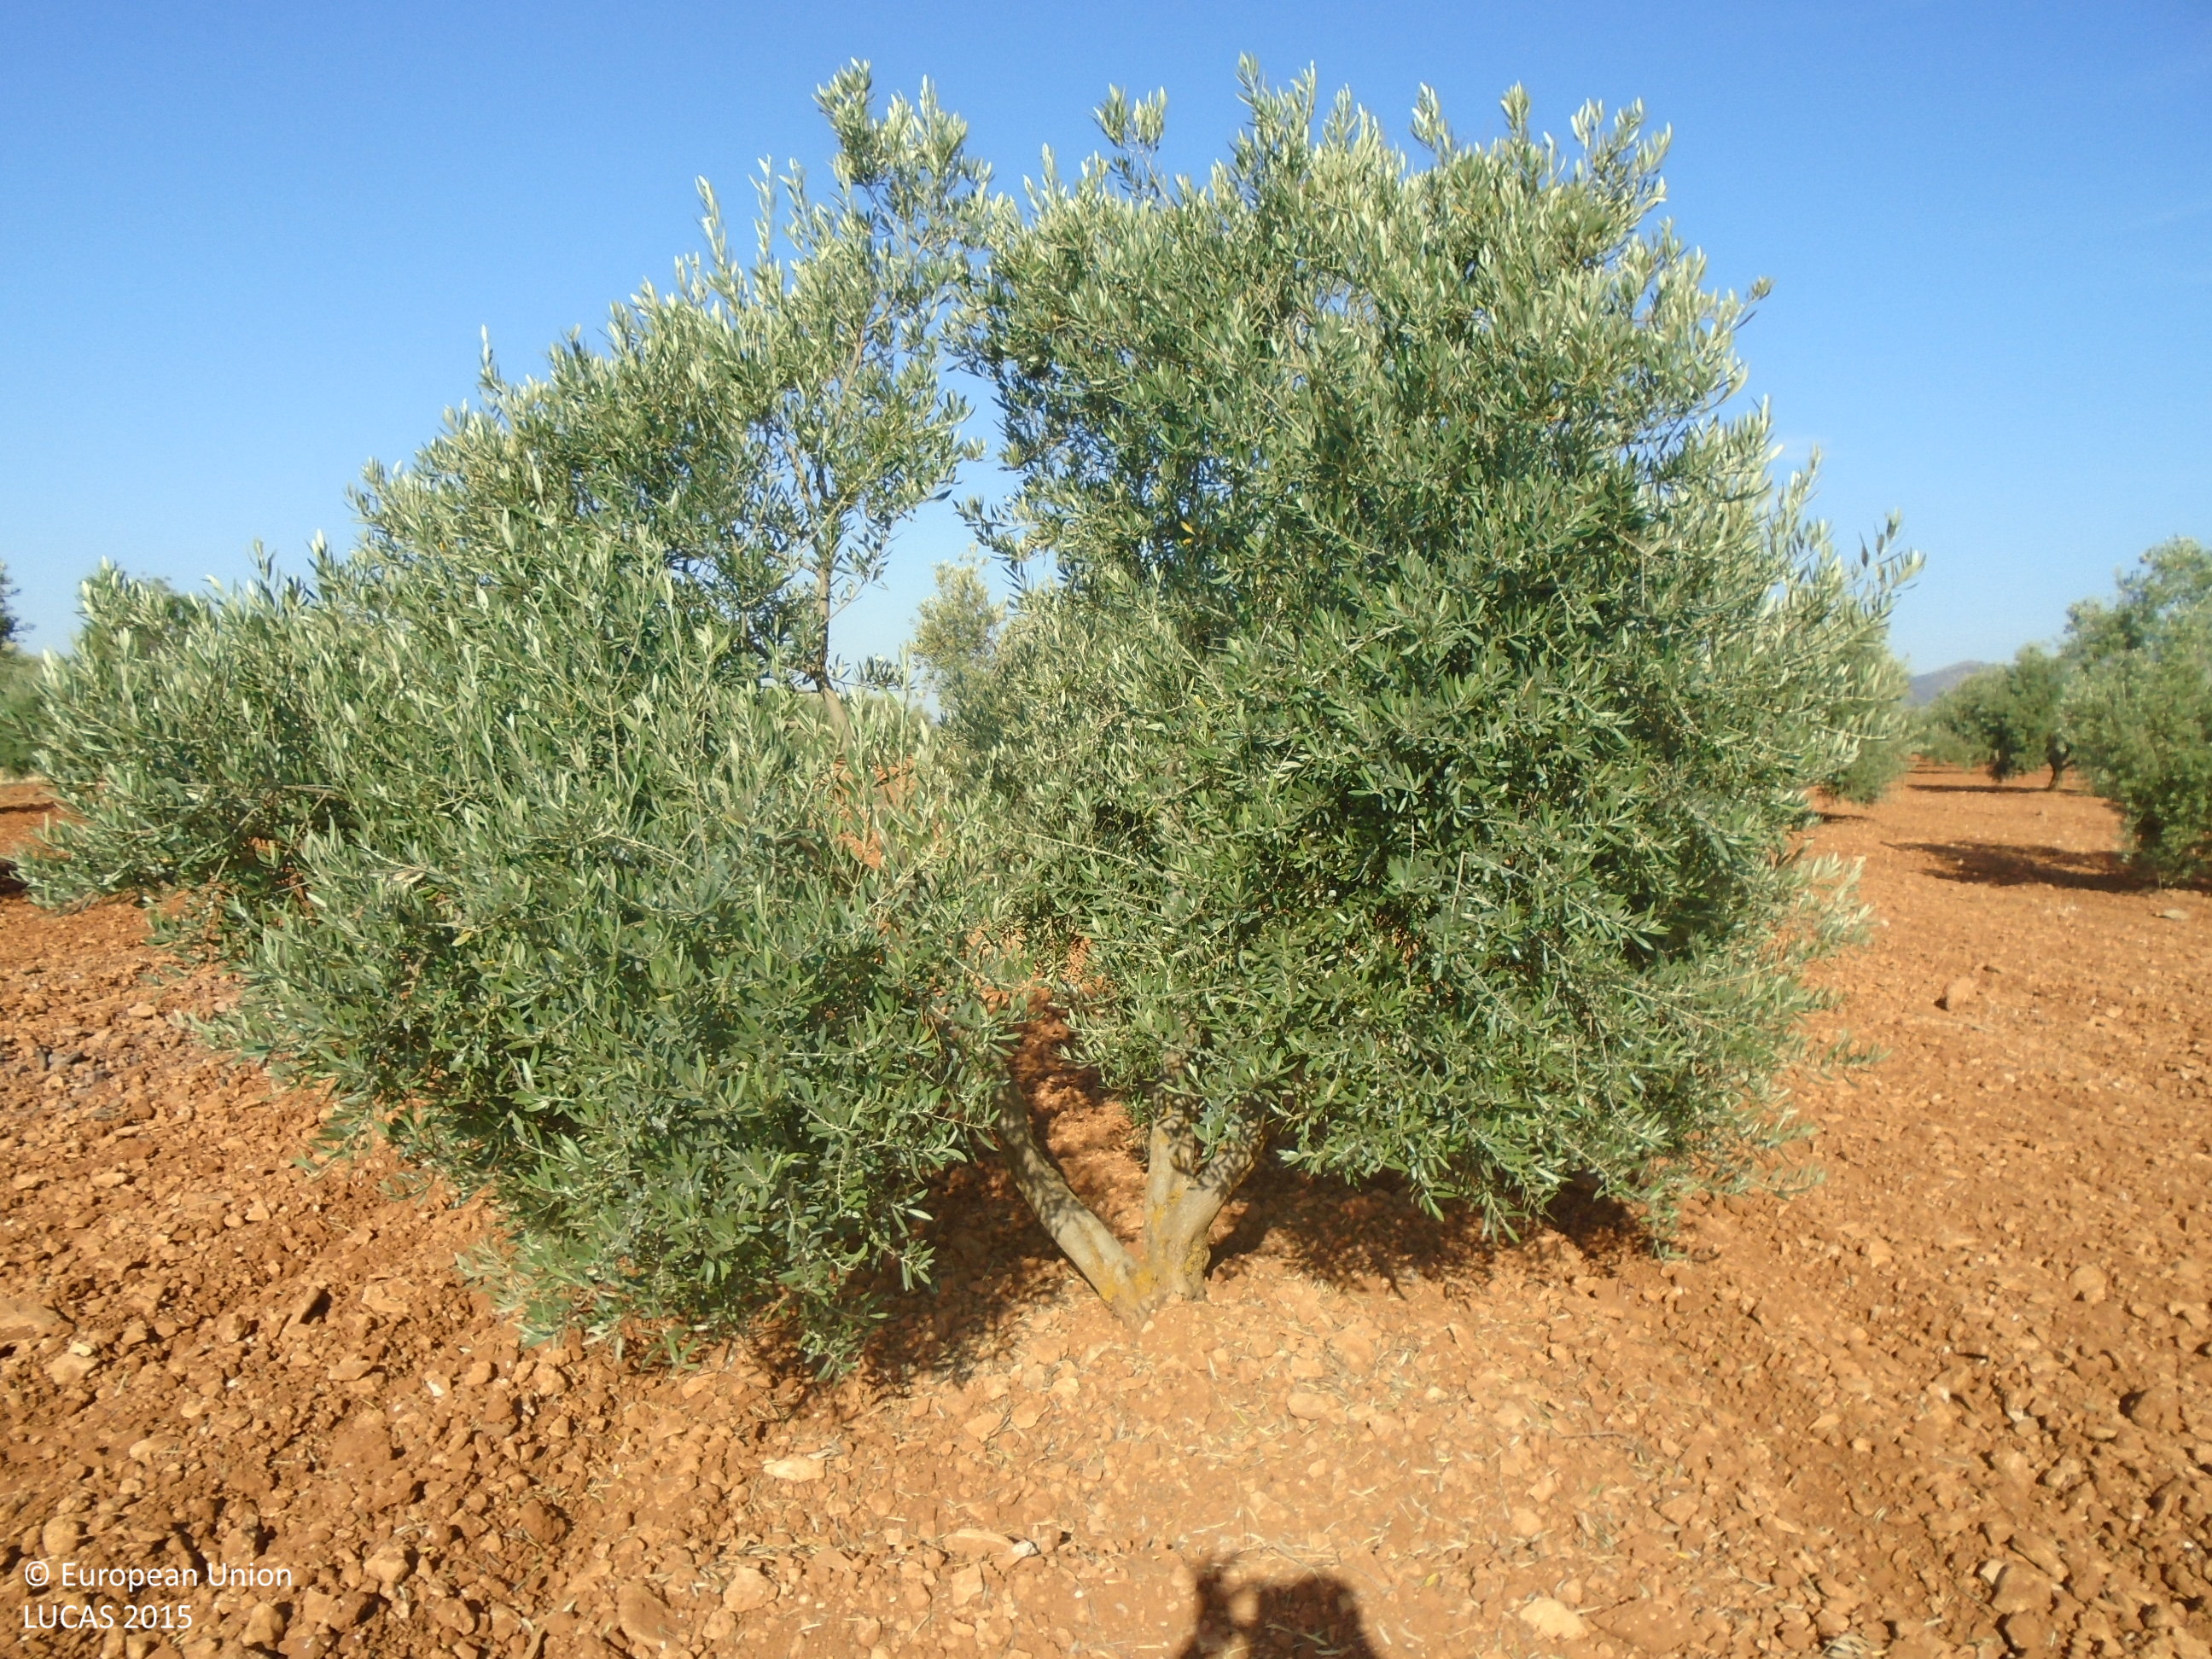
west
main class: Cropland
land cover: Olive groves
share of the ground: 10 - 25 %
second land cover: Other bare soil
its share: > 75 %
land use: Agriculture (excluding fallow land and kitchen gardens)
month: June
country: ES
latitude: 39.2535
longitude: -3.5197
